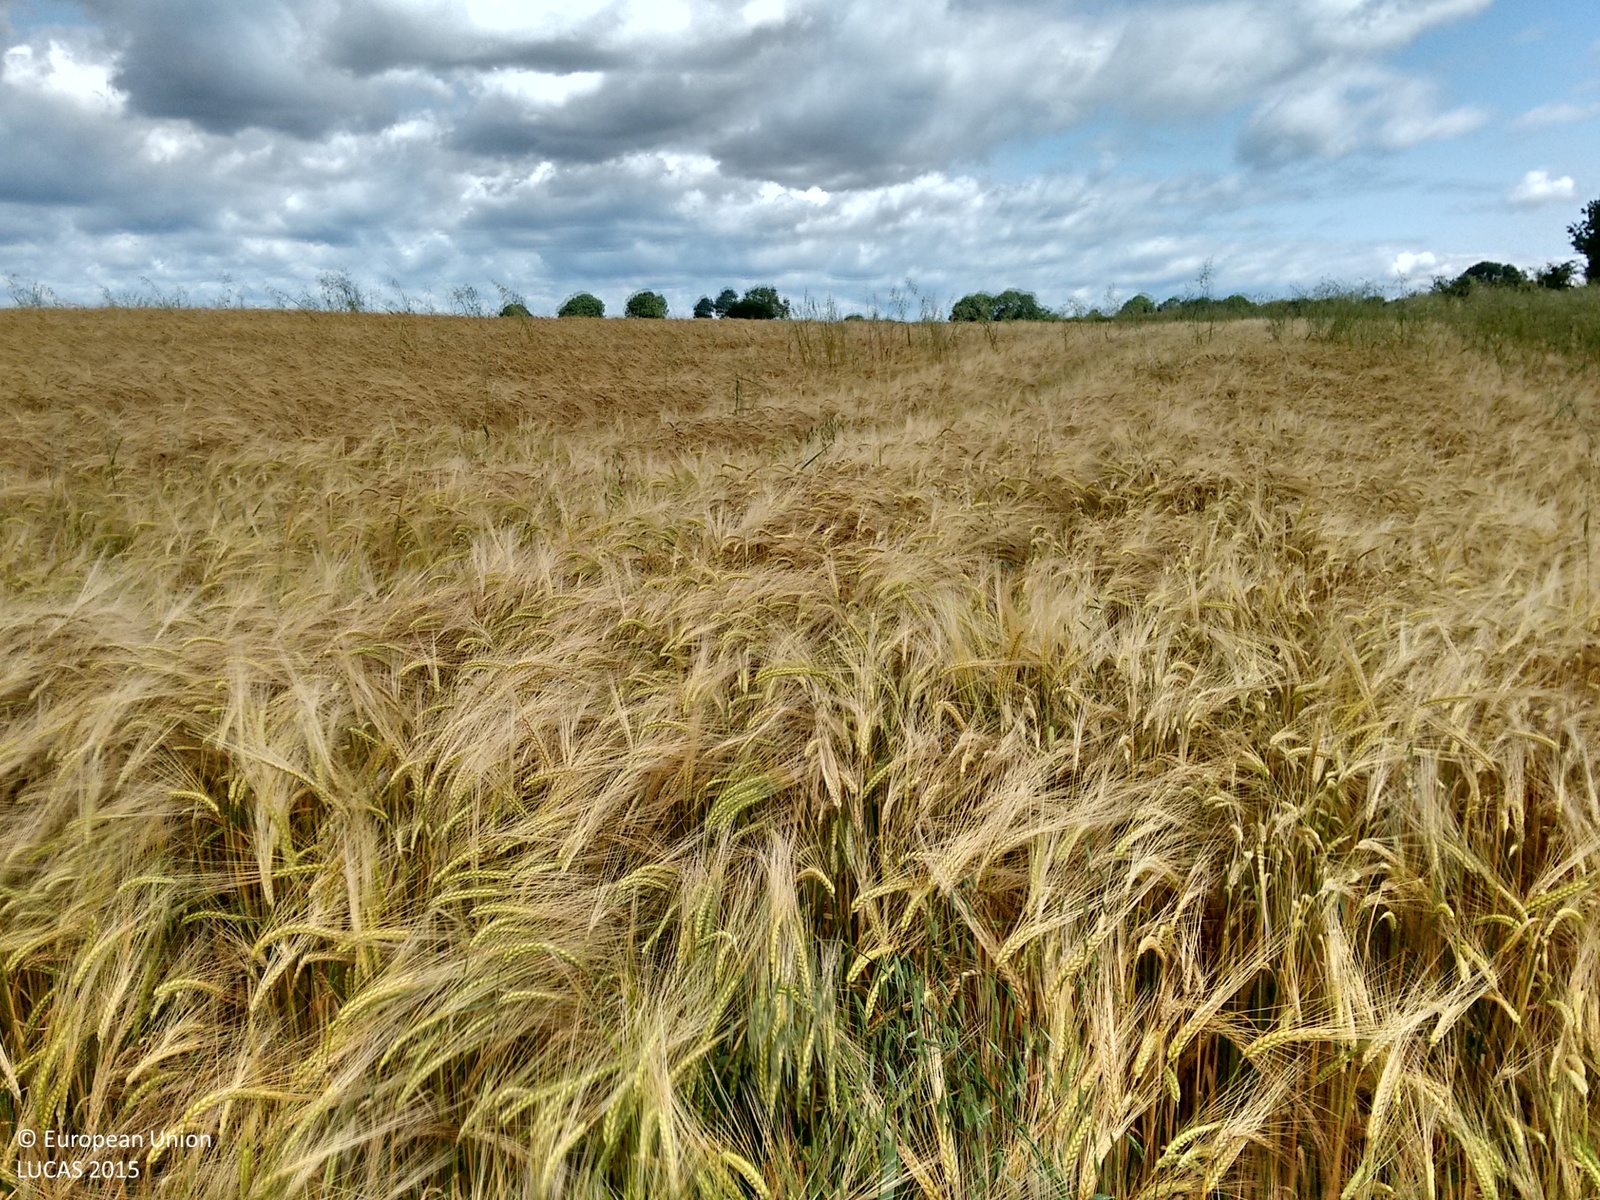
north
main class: Cropland
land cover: Triticale
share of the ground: > 75 %
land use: Agriculture (excluding fallow land and kitchen gardens)
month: July
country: IE
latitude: 52.6477
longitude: -7.6185
